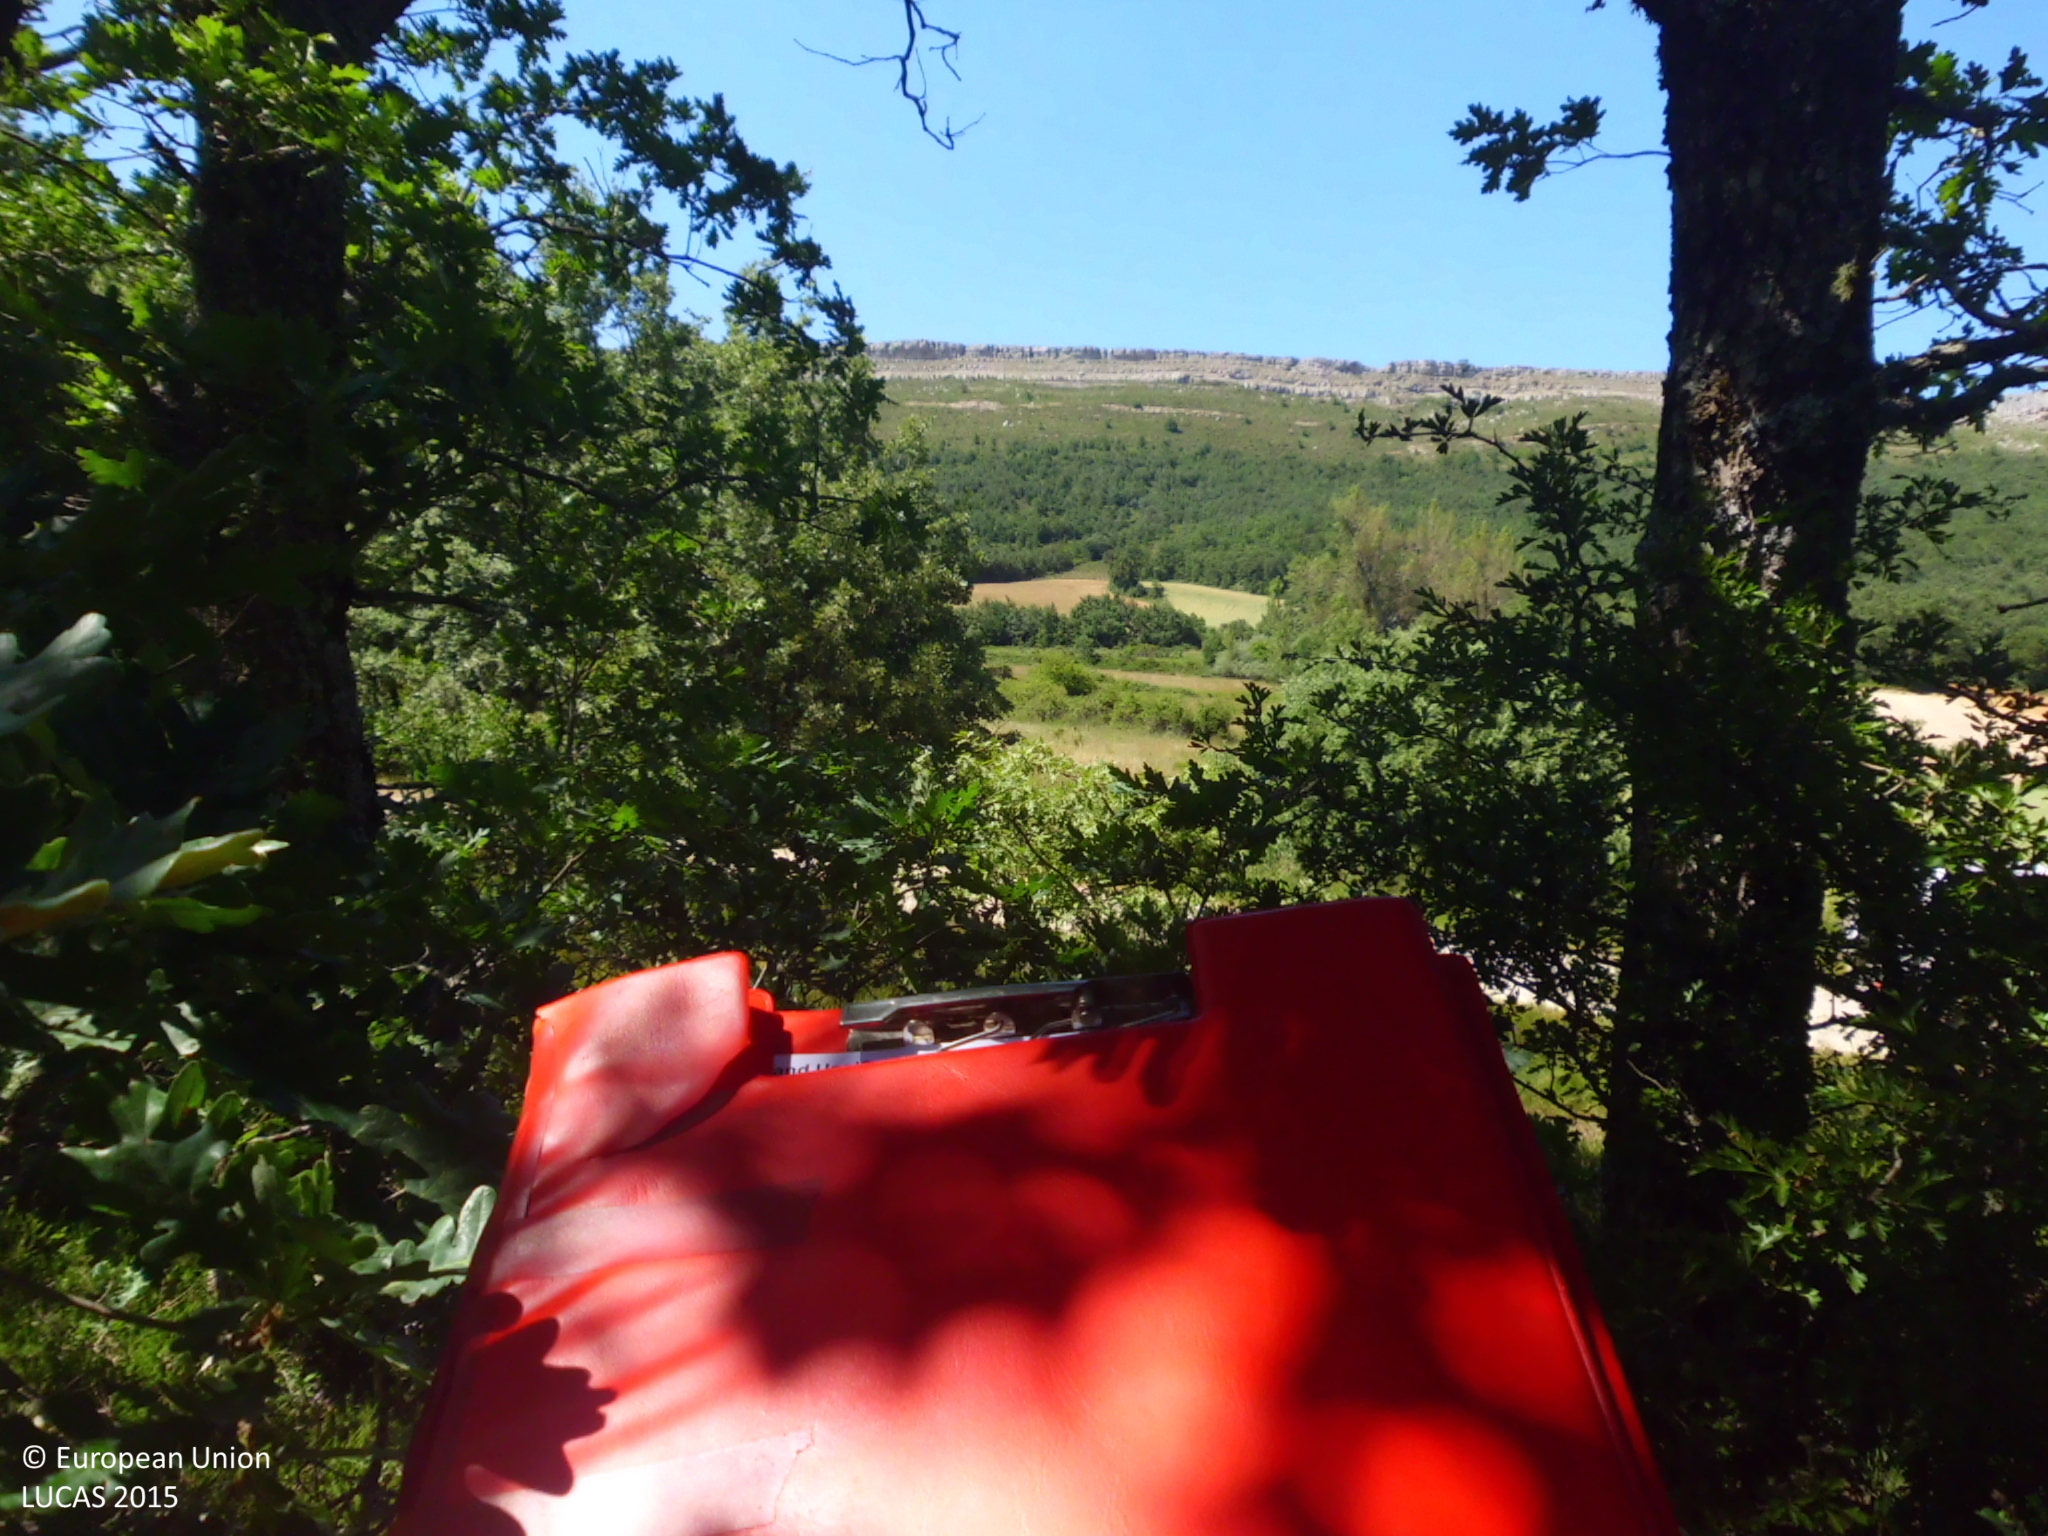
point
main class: Woodland
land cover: Broadleaved woodland
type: acidophilous oak and oak-birch forest
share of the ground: 25 - 50 %
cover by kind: broadleaved forest trees 40 %, shrubs 40 %, consolidated bare surface 15 %, herbaceous plants 5 %
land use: Semi-natural and natural areas not in use
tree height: > 5 m
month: June
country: ES
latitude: 42.6237
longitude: -4.0293
